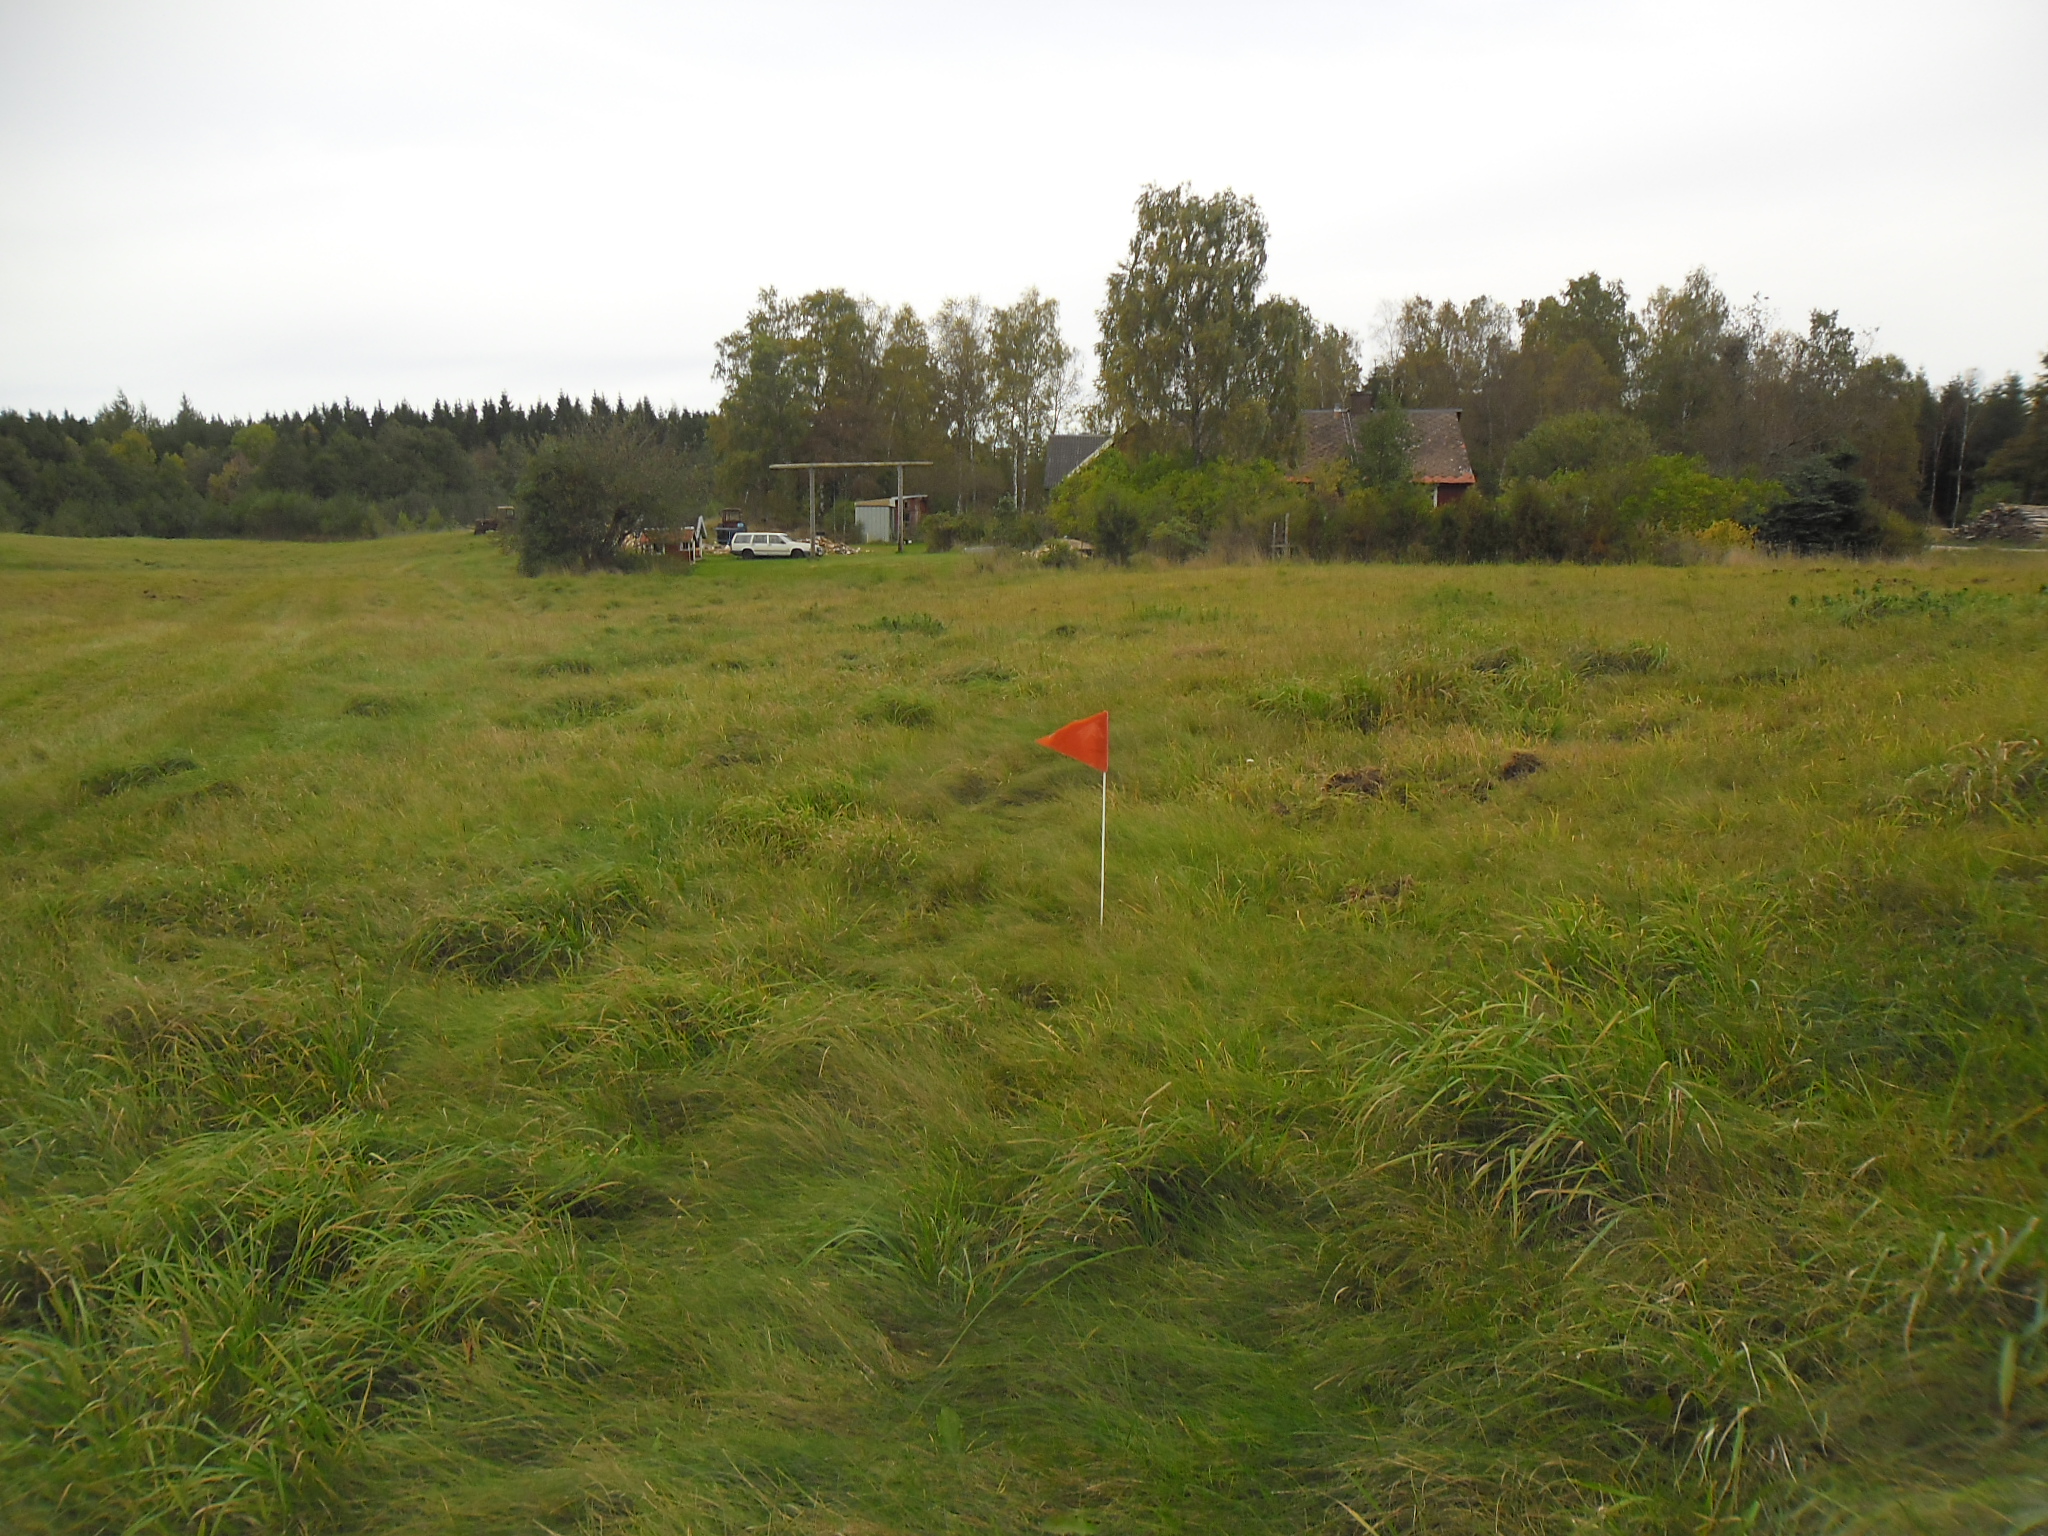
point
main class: Grassland
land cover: Grassland without tree/shrub cover
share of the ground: > 75 %
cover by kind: herbaceous plants 100 %
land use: Agriculture (excluding fallow land and kitchen gardens)
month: October
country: SE
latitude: 56.5617
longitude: 13.2025
